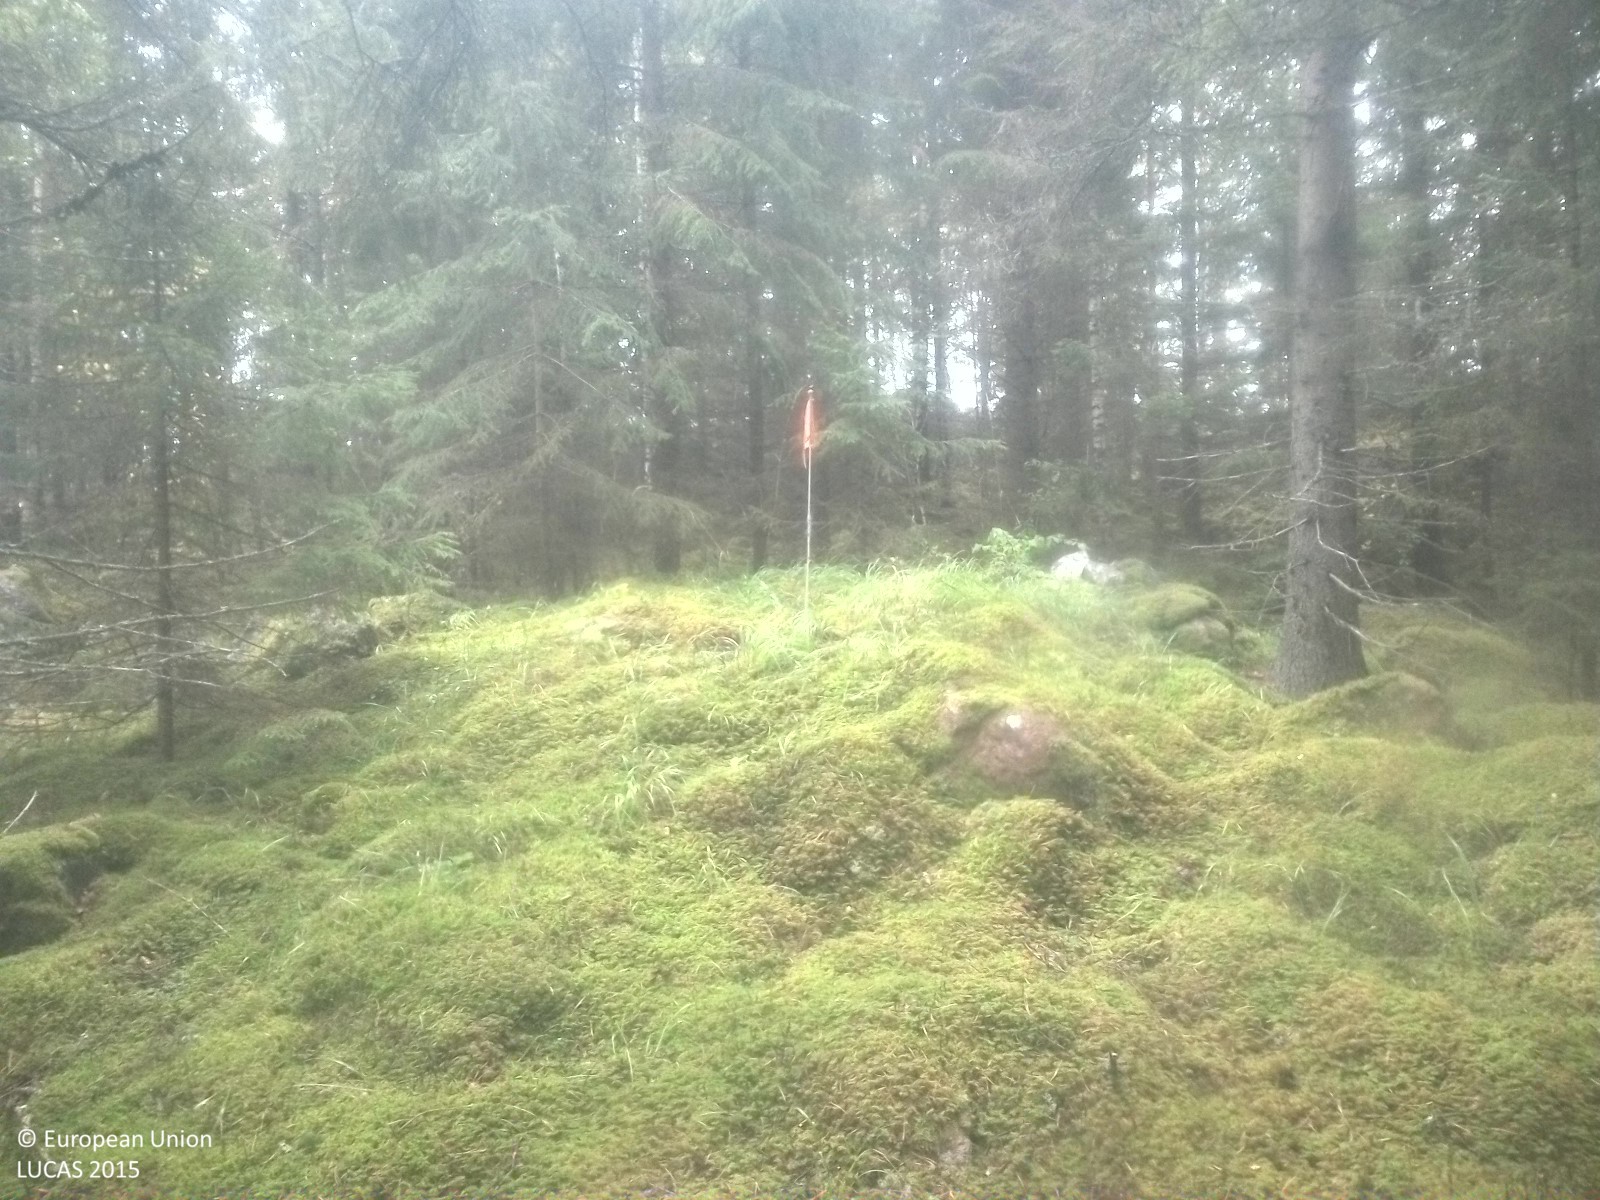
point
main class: Woodland
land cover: Spruce dominated coniferous woodland
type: boreal forest
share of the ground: 50 - 75 %
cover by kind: coniferous forest trees 60 %, lichens and mosses 30 %, herbaceous plants 10 %
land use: Forestry
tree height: > 5 m
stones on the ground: 10 - 25 %
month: September
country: SE
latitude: 58.7969
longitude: 15.8257
